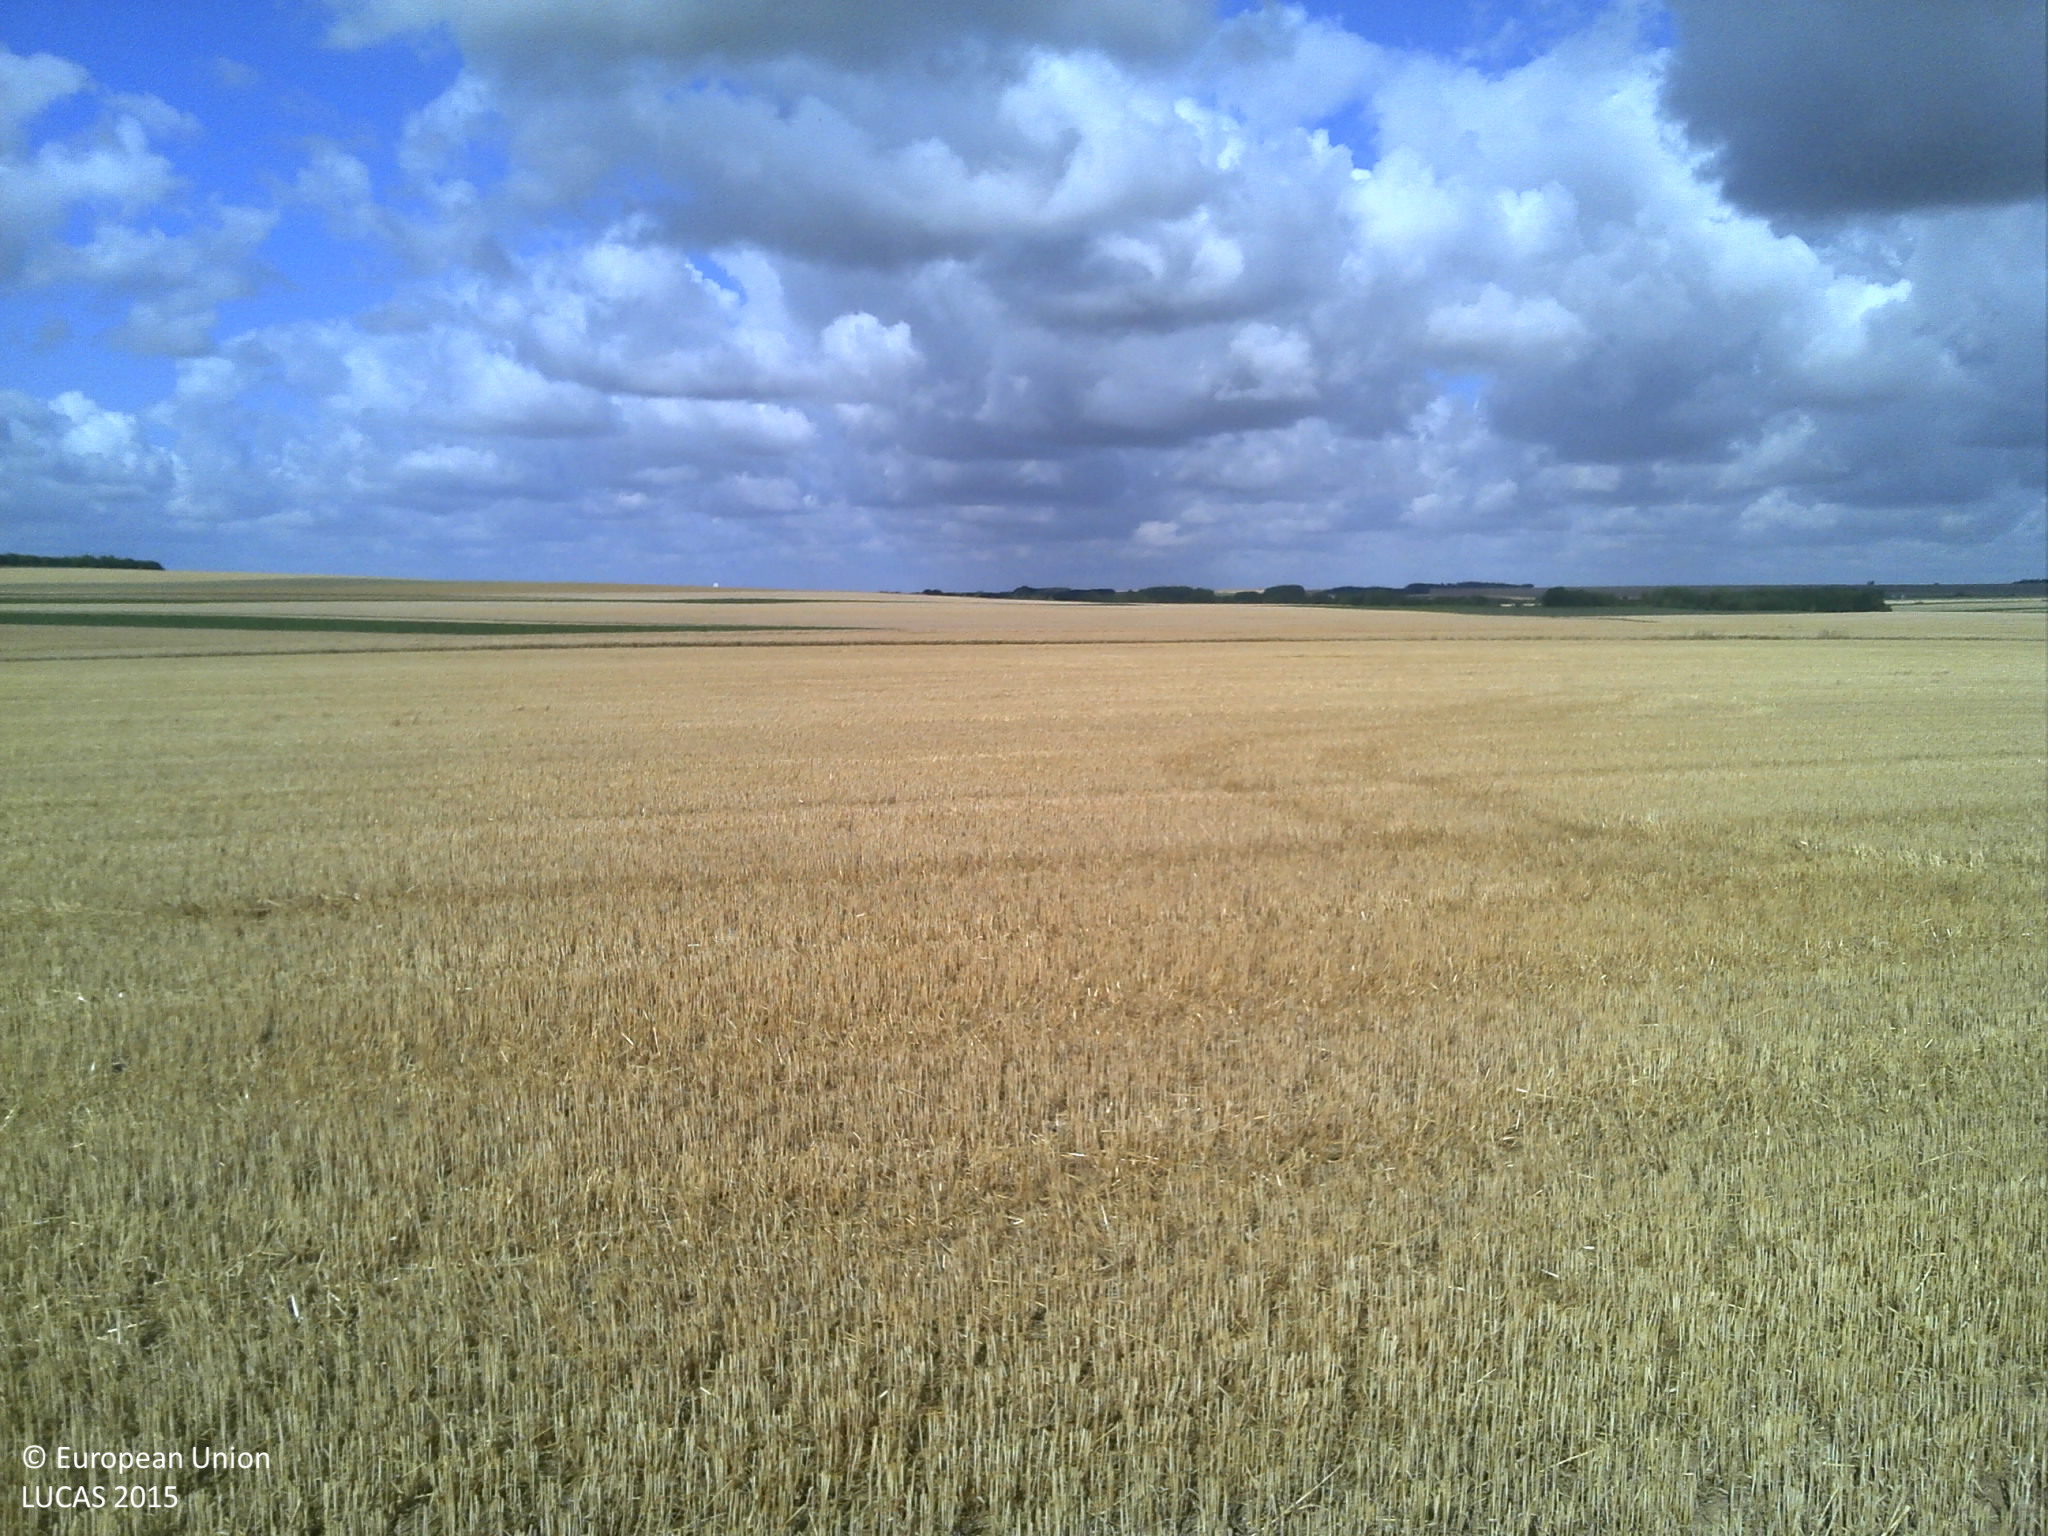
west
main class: Cropland
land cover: Barley
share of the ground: 50 - 75 %
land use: Agriculture (excluding fallow land and kitchen gardens)
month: July
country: FR
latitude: 49.3142
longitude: 4.5354
